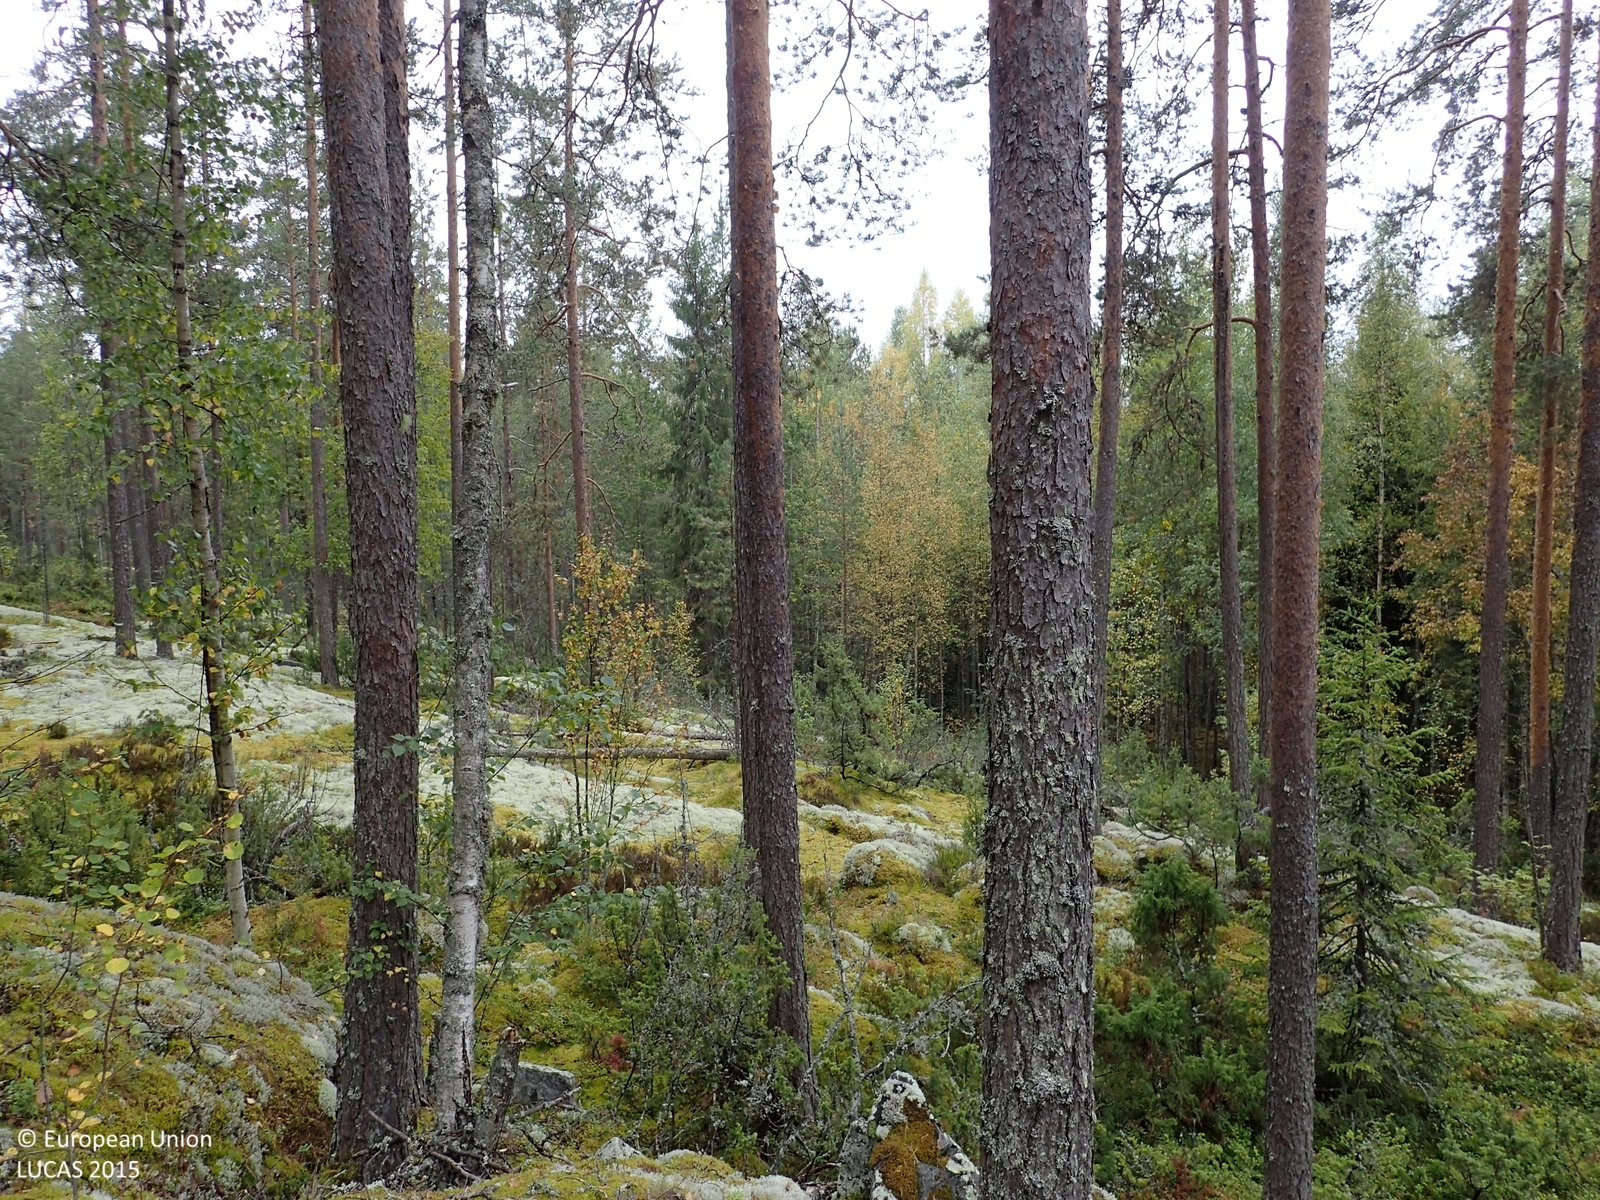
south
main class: Woodland
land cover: Pine dominated mixed woodland
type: boreal forest
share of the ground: > 75 %
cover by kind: coniferous forest trees 55 %, broadleaved forest trees 20 %, lichens and mosses 15 %, shrubs 10 %
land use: Forestry
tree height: > 5 m
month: September
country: FI
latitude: 63.0650
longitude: 25.6022
